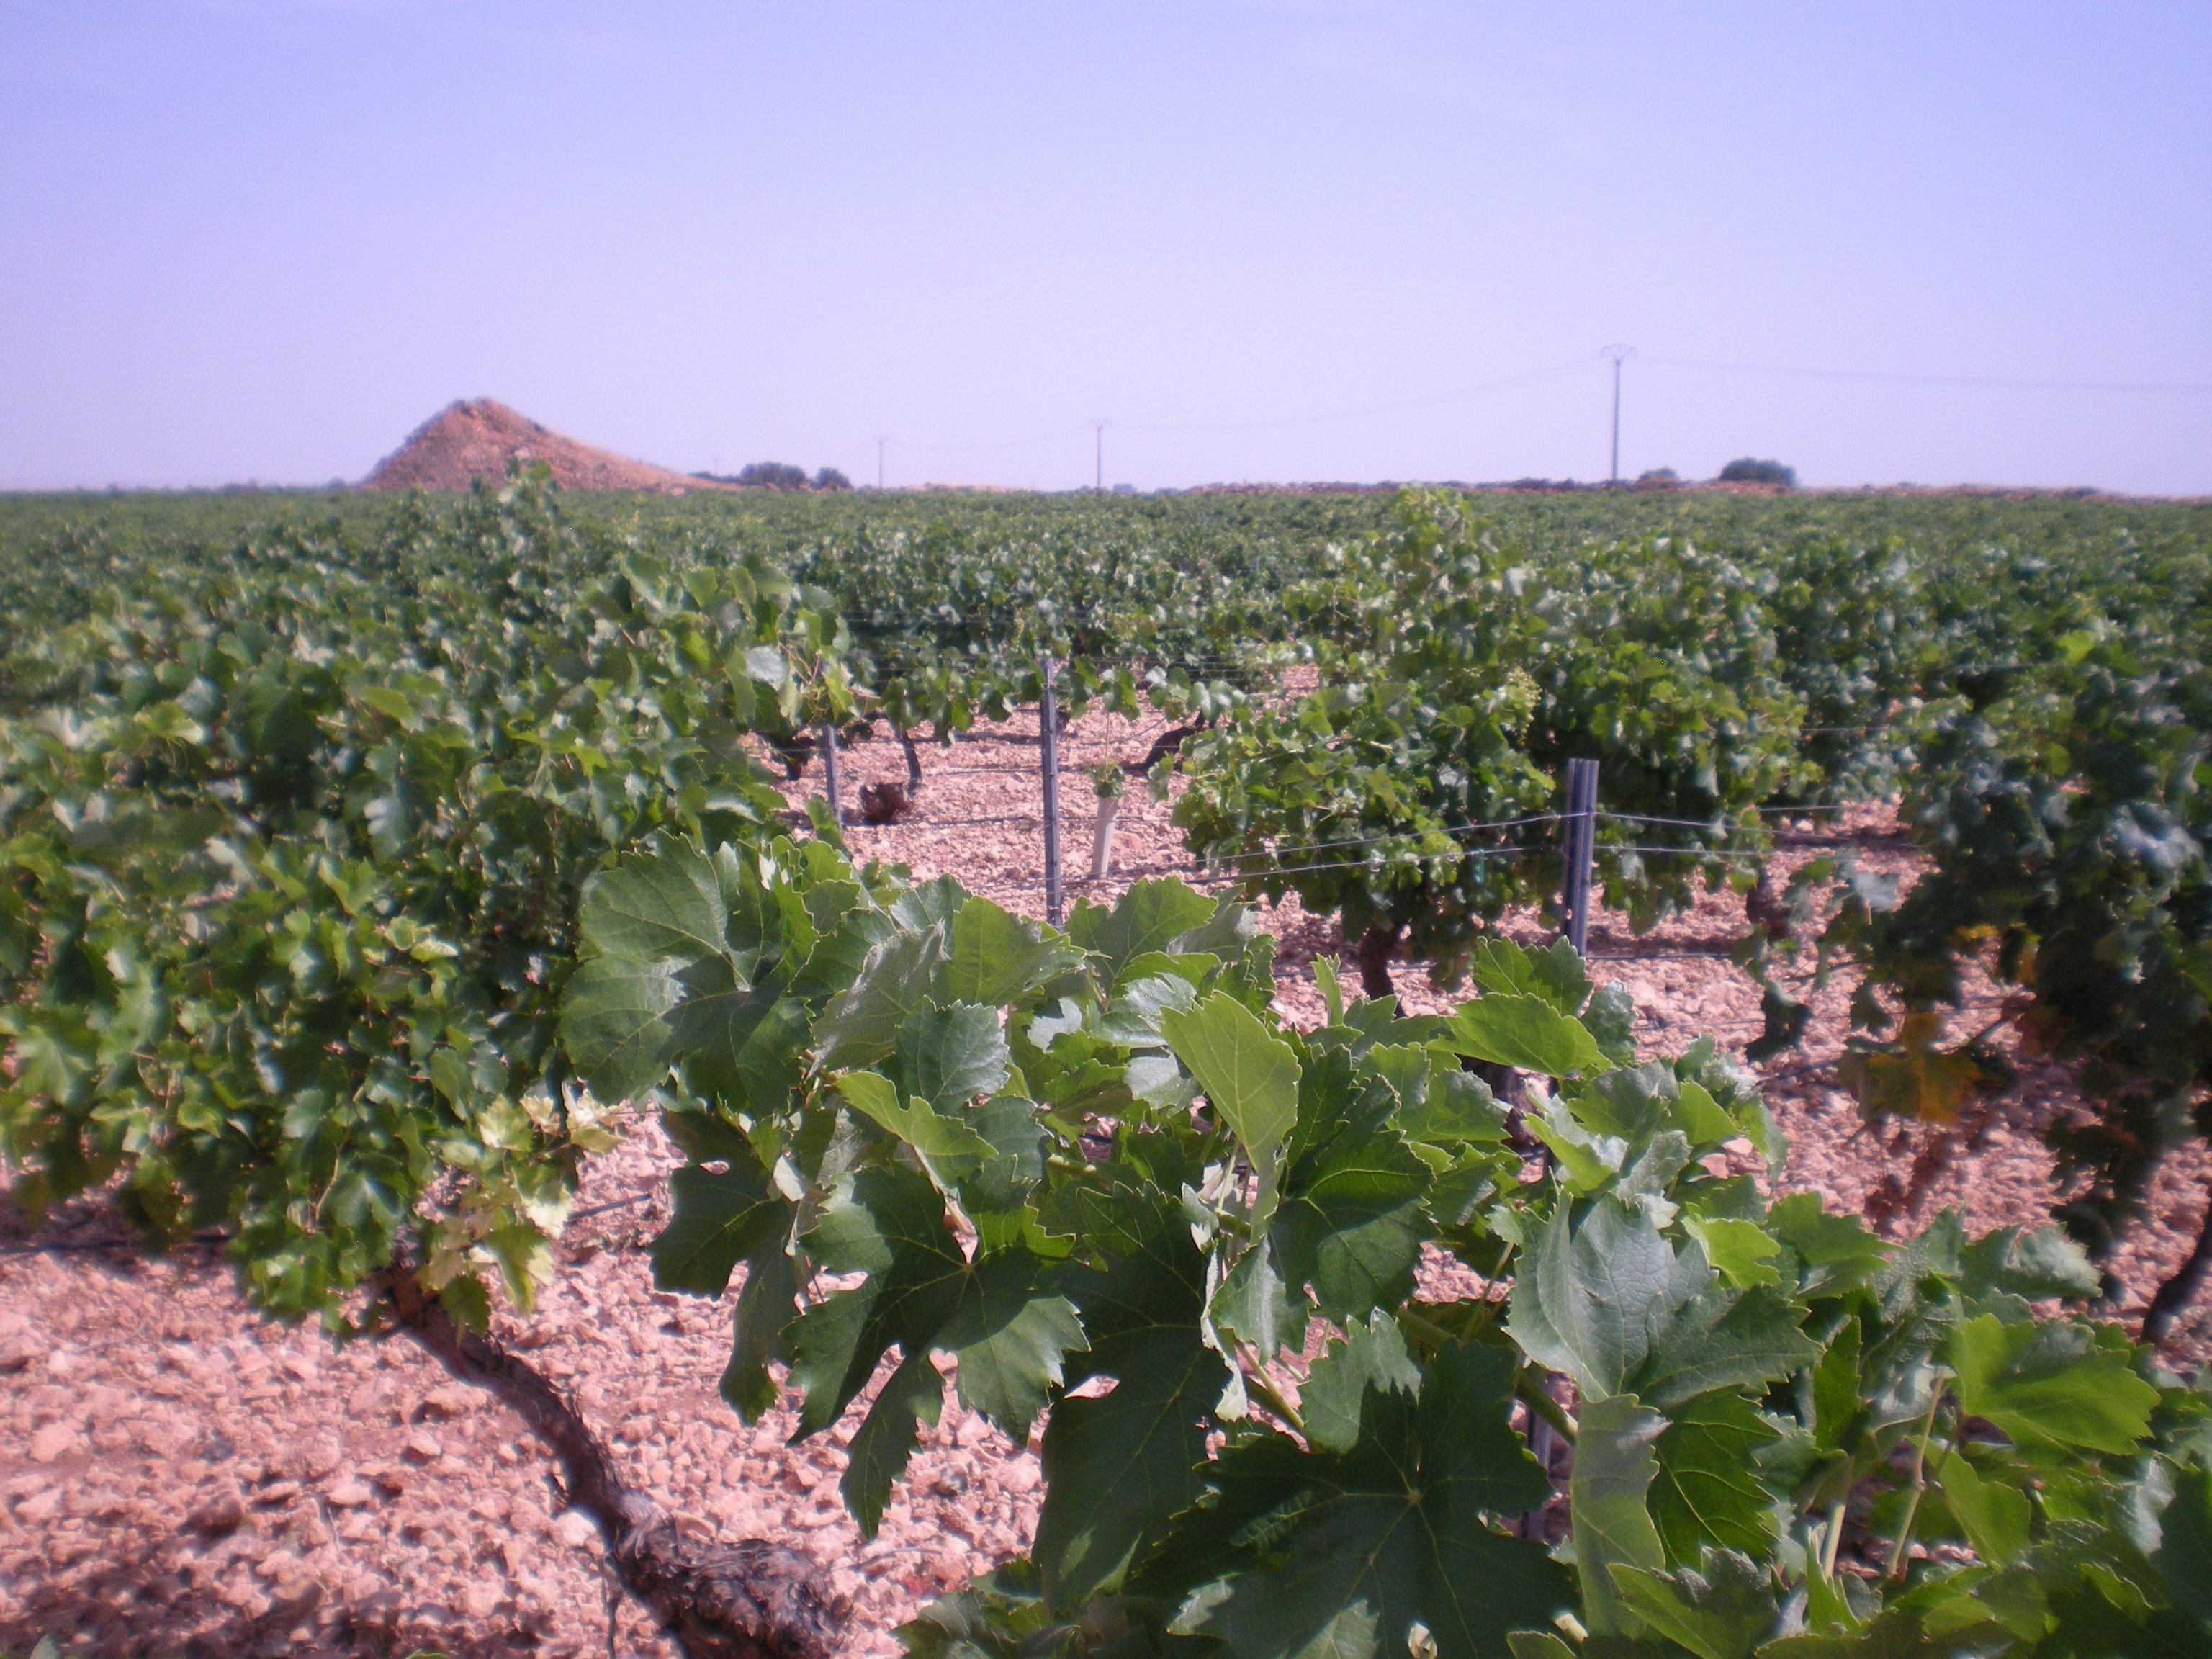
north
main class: Cropland
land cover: Vineyards
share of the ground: 10 - 25 %
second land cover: Other bare soil
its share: > 75 %
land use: Agriculture (excluding fallow land and kitchen gardens)
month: July
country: ES
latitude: 39.1994
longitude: -3.2508
